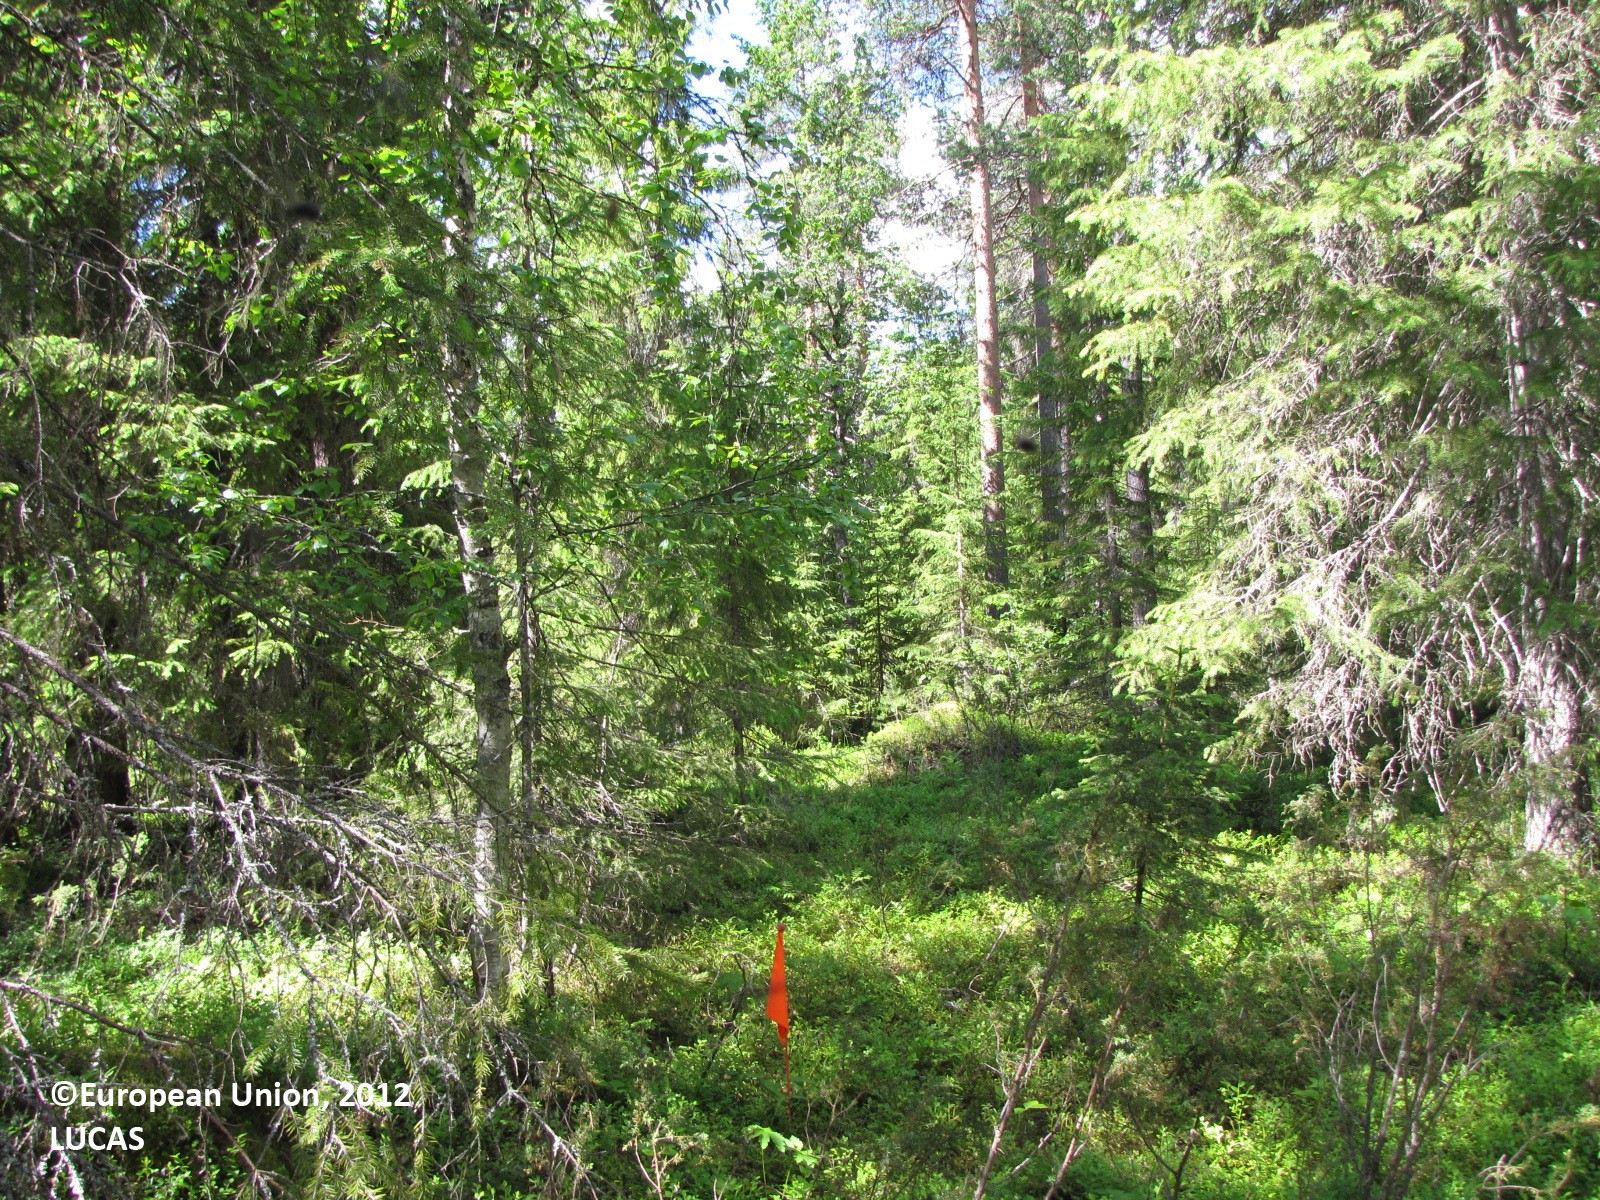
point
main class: Woodland
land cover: Spruce dominated coniferous woodland
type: boreal forest
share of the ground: 50 - 75 %
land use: Forestry
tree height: > 5 m
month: July
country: FI
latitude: 66.1811
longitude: 25.1281
